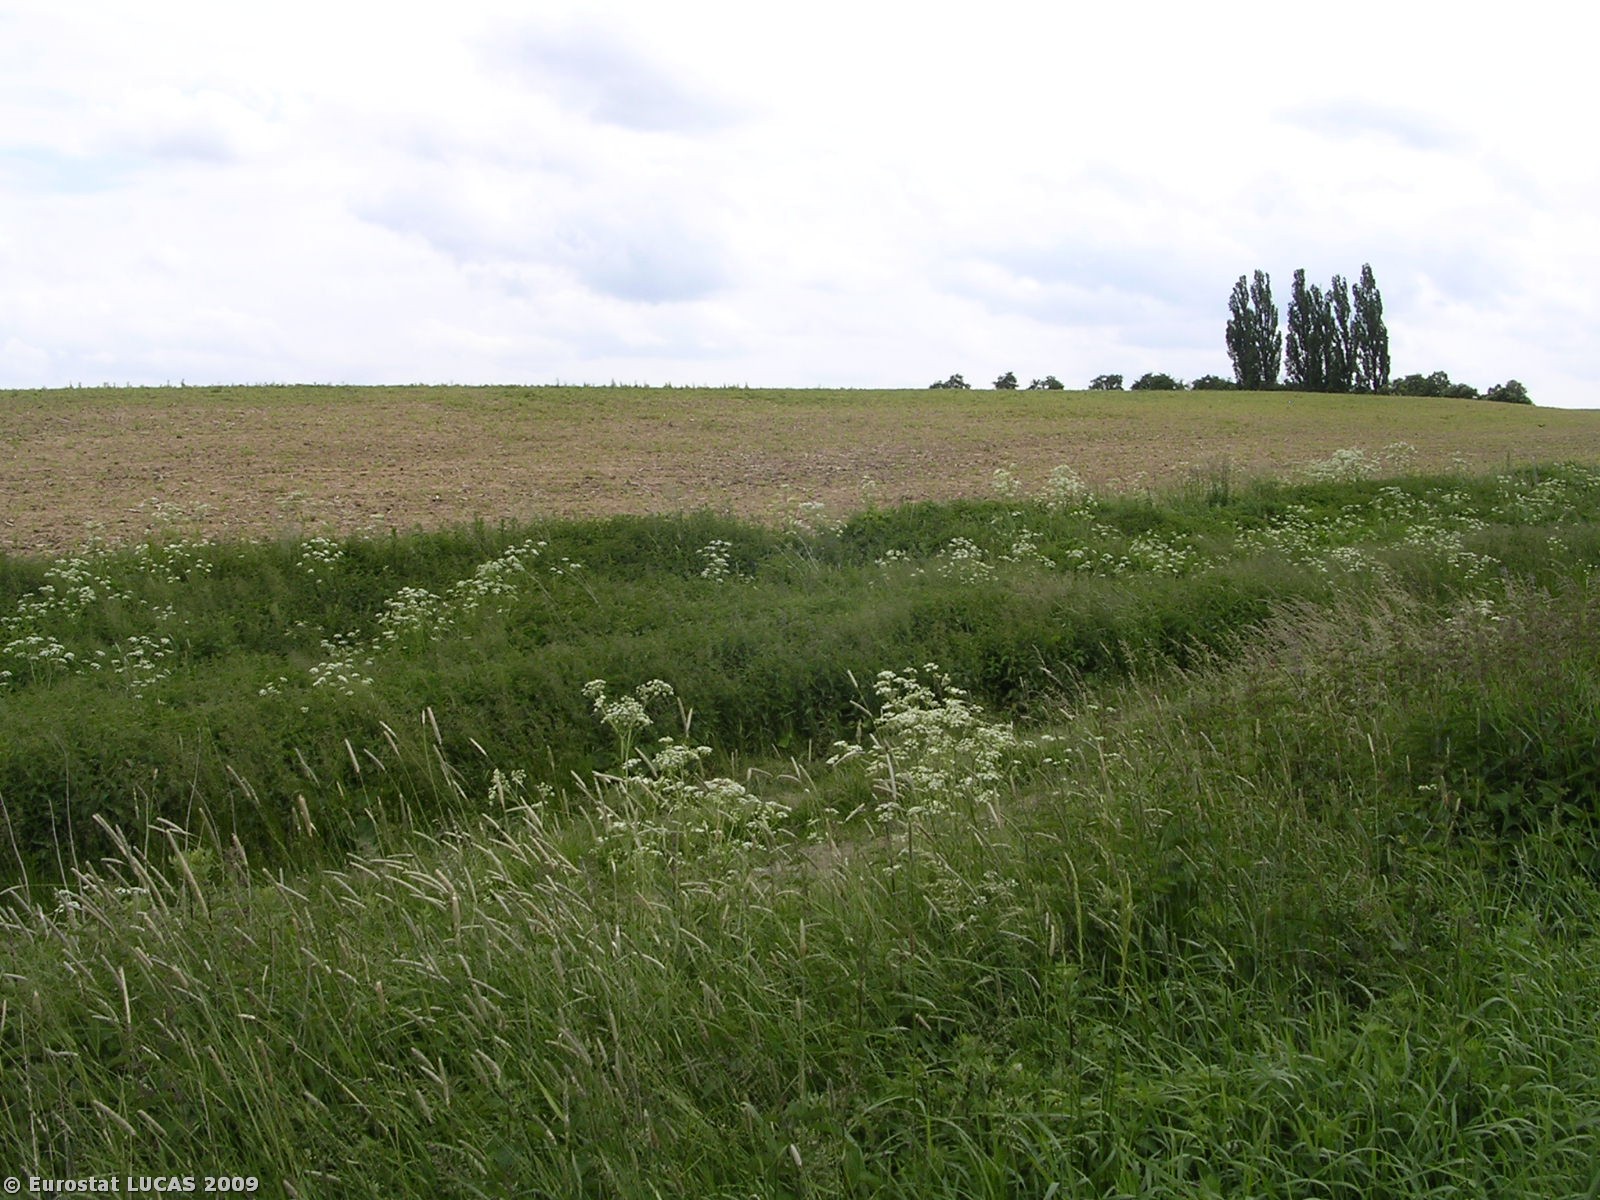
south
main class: Cropland
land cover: Barley
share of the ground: > 75 %
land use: Agriculture (excluding fallow land and kitchen gardens)
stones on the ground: < 10 %
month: June
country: CZ
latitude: 50.4827
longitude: 14.7234
